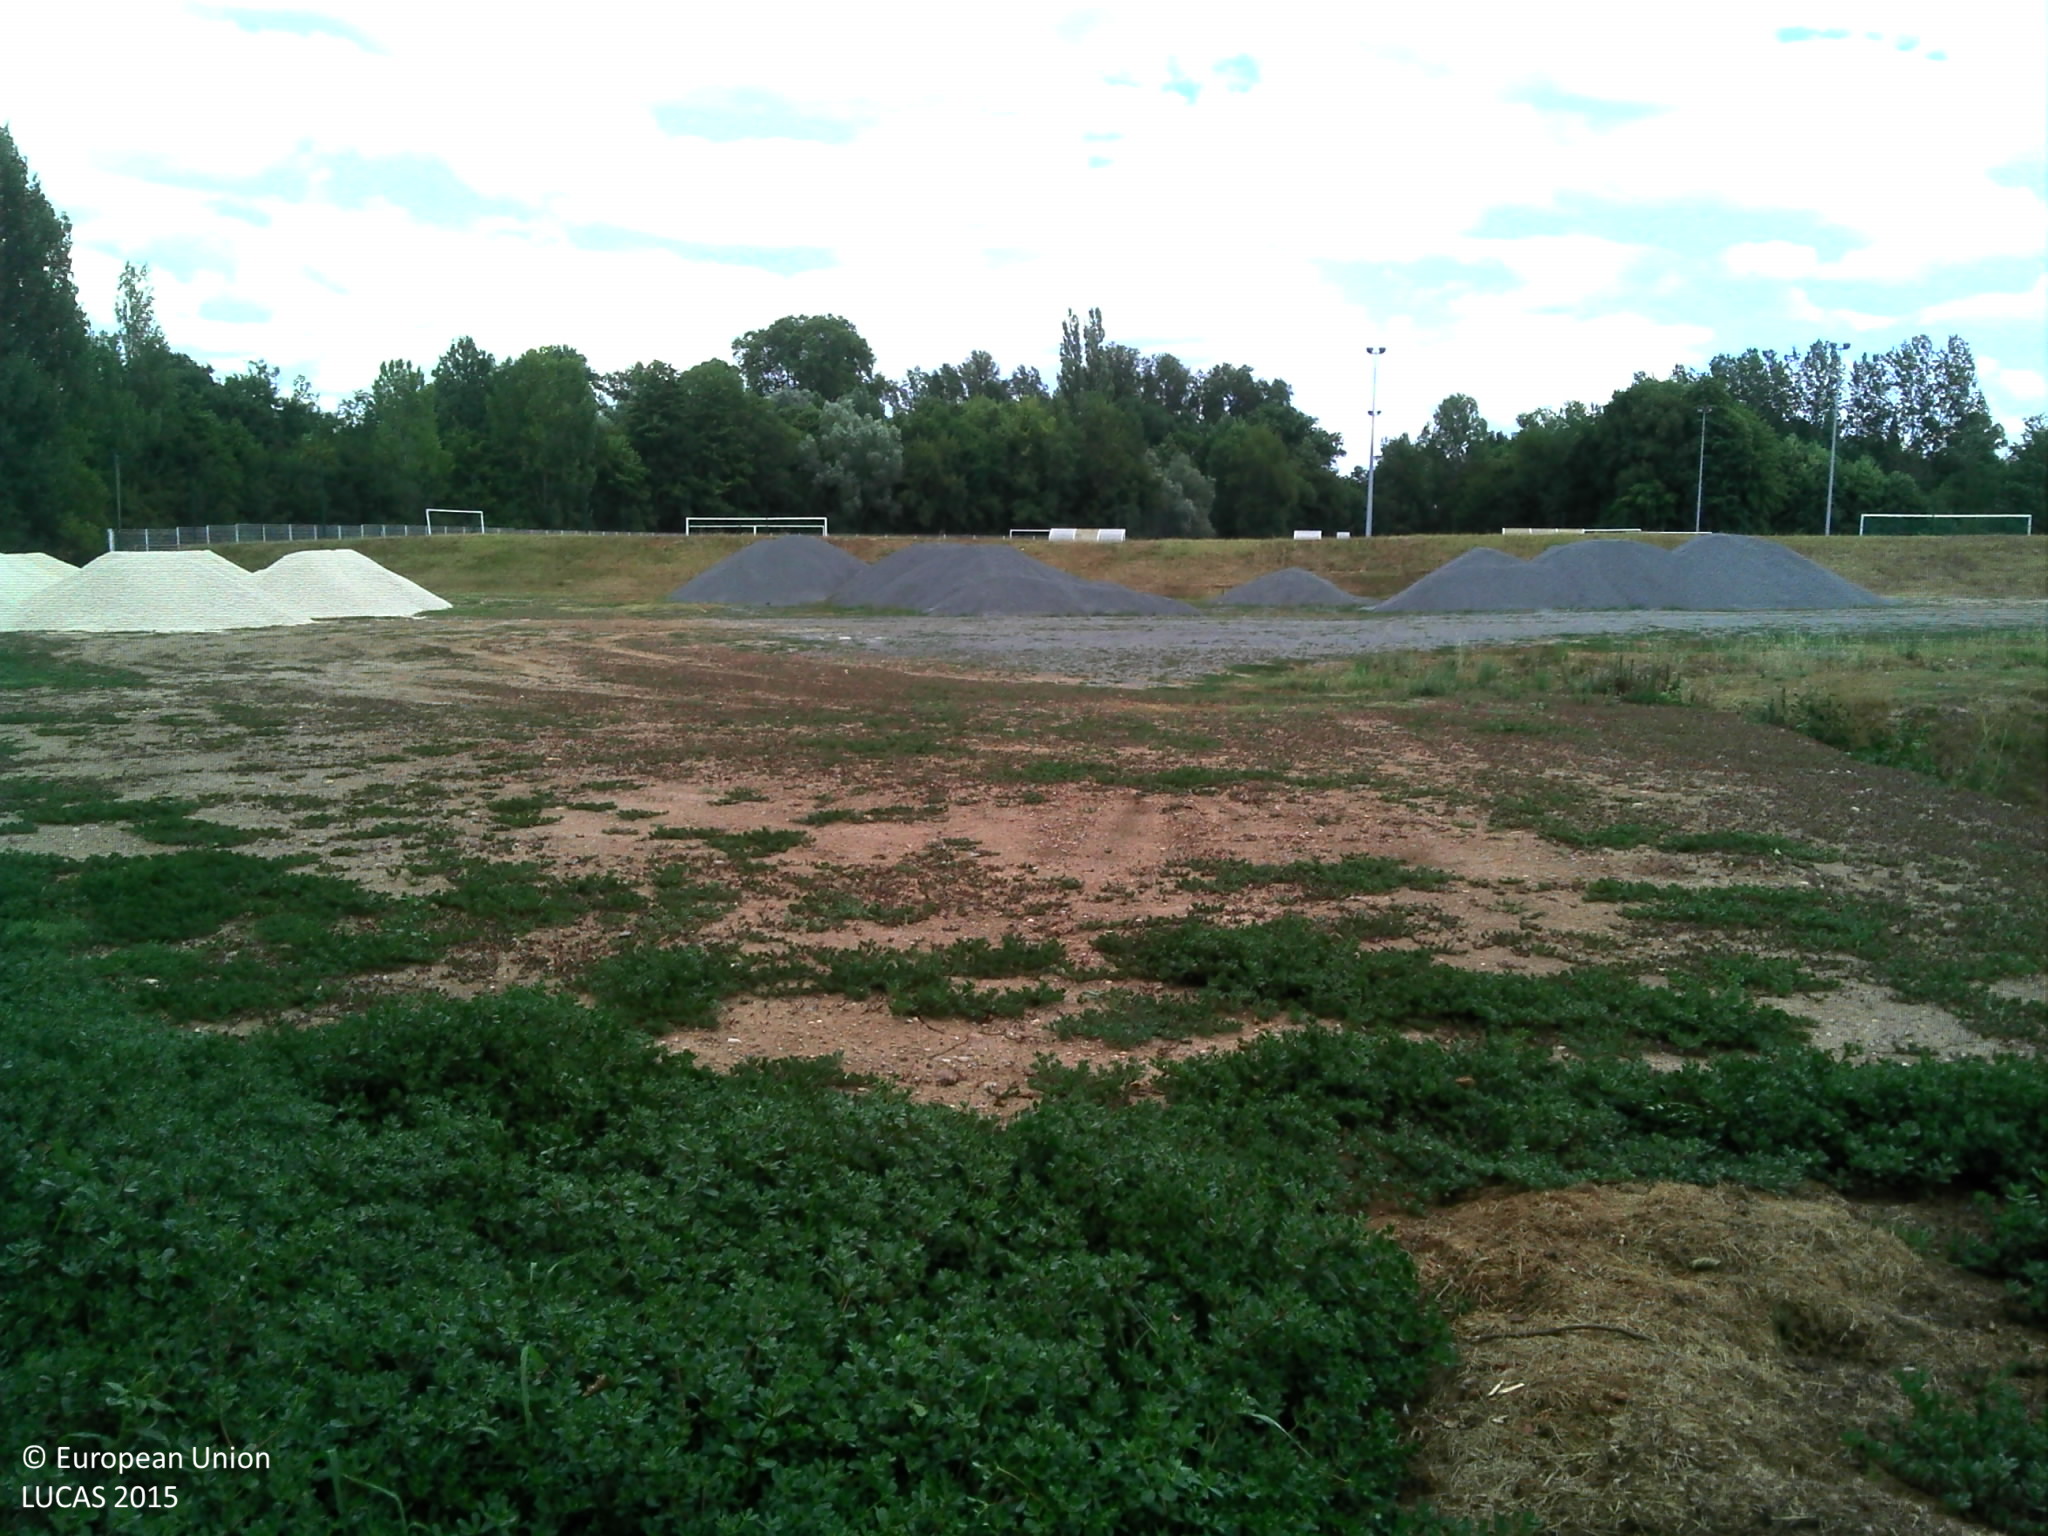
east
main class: Grassland
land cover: Spontaneously vegetated surfaces
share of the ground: > 75 %
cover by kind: unconsolidated bare surface 60 %, herbaceous plants 40 %
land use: Abandoned areas
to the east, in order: Spontaneously vegetated surfaces; Other bare soil; Artificial constructions in urban areas; Grassland without tree/shrub cover; Fences; Grassland without tree/shrub cover; Rock outcrops; Broadleaved woodland; Rivers and streams; Broadleaved woodland
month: July
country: FR
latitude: 44.4186
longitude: 0.6620
